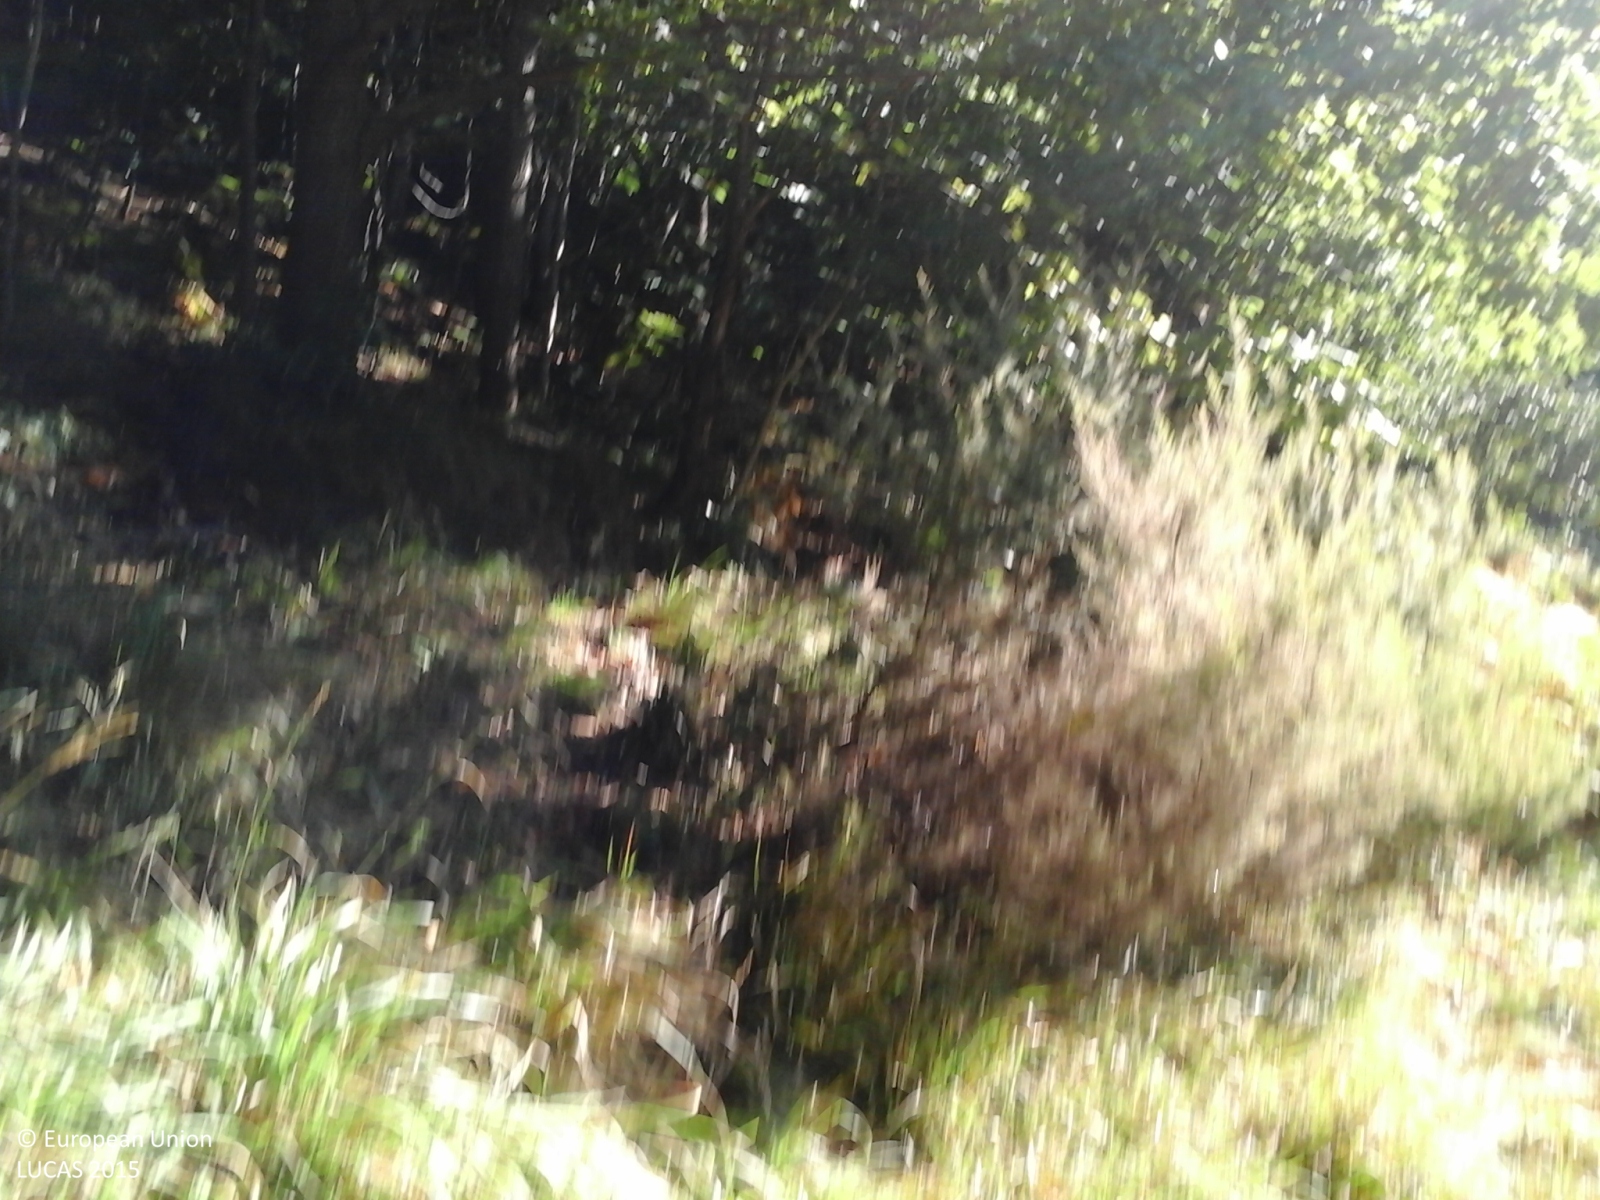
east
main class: Woodland
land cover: Broadleaved woodland
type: thermophilous deciduous forest
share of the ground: > 75 %
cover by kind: broadleaved forest trees 100 %
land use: Semi-natural and natural areas not in use
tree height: > 5 m
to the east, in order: Broadleaved woodland; Grassland without tree/shrub cover
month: September
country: IT
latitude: 44.5583
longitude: 8.6558
